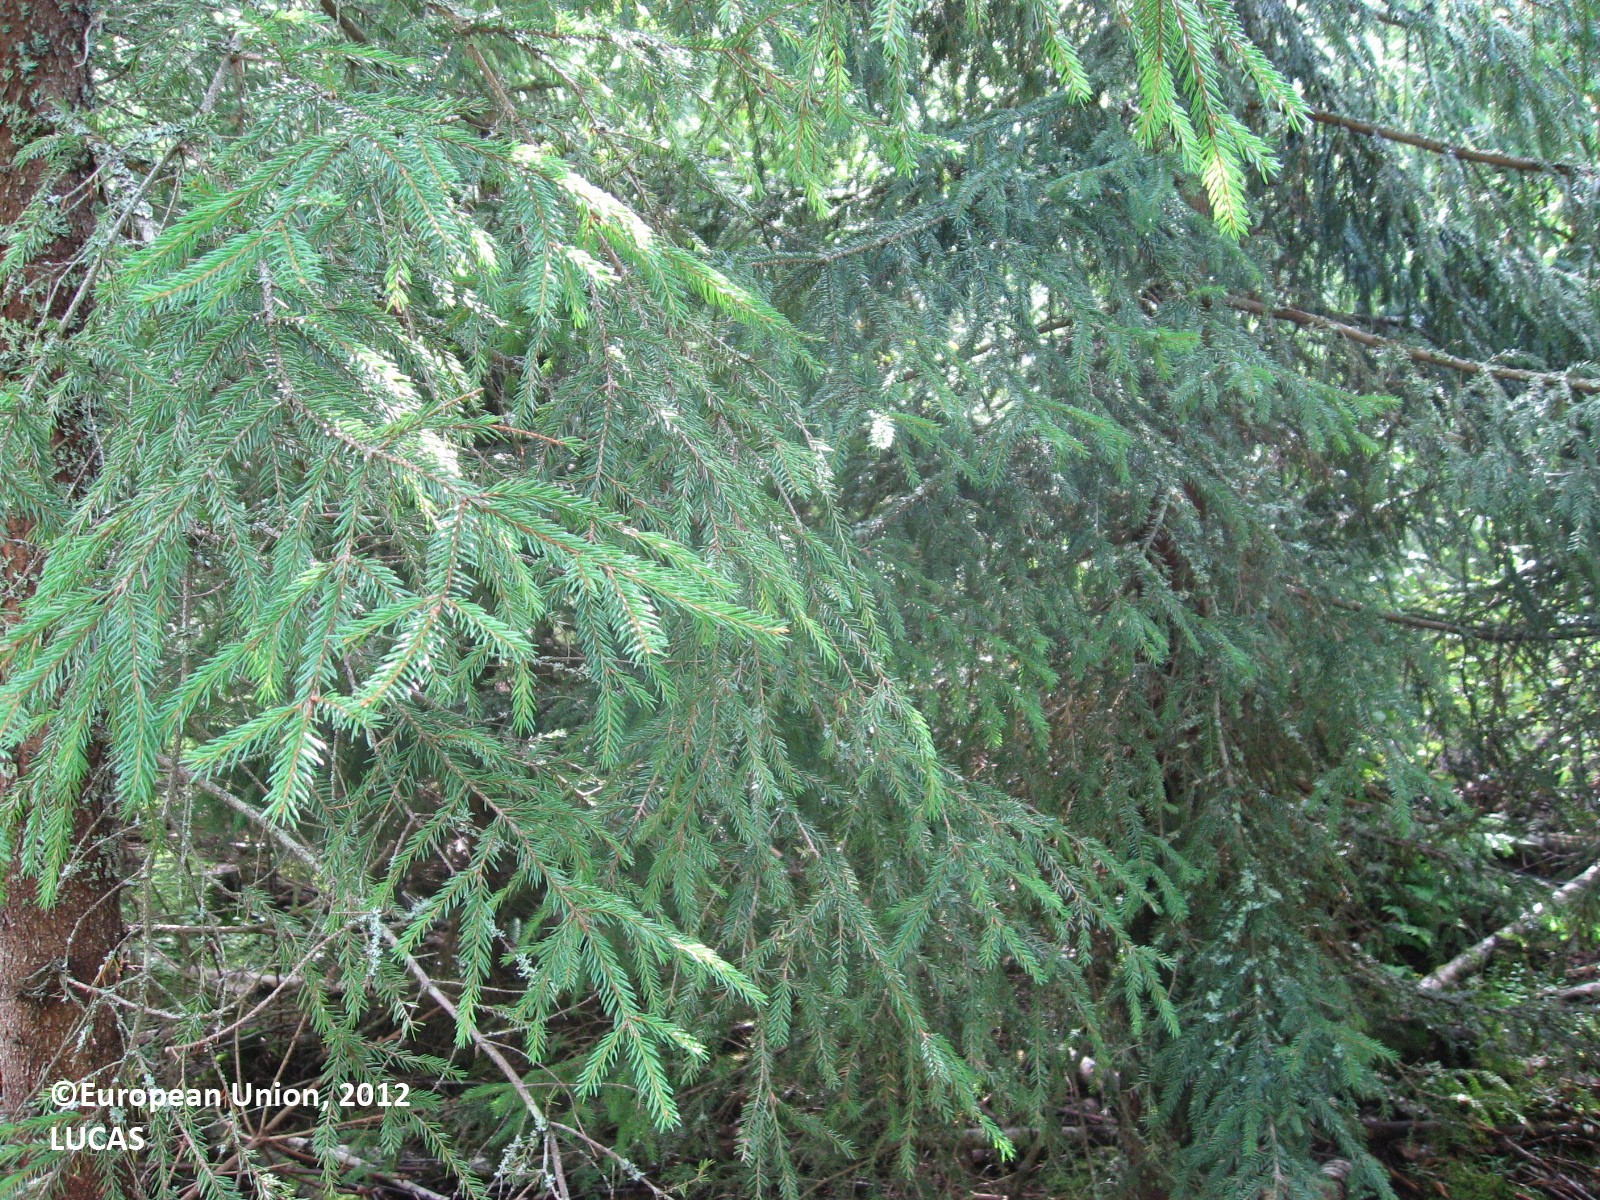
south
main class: Woodland
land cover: Spruce dominated mixed woodland
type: boreal forest
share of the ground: > 75 %
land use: Forestry
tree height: > 5 m
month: August
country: FI
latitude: 60.7882
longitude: 25.1630
